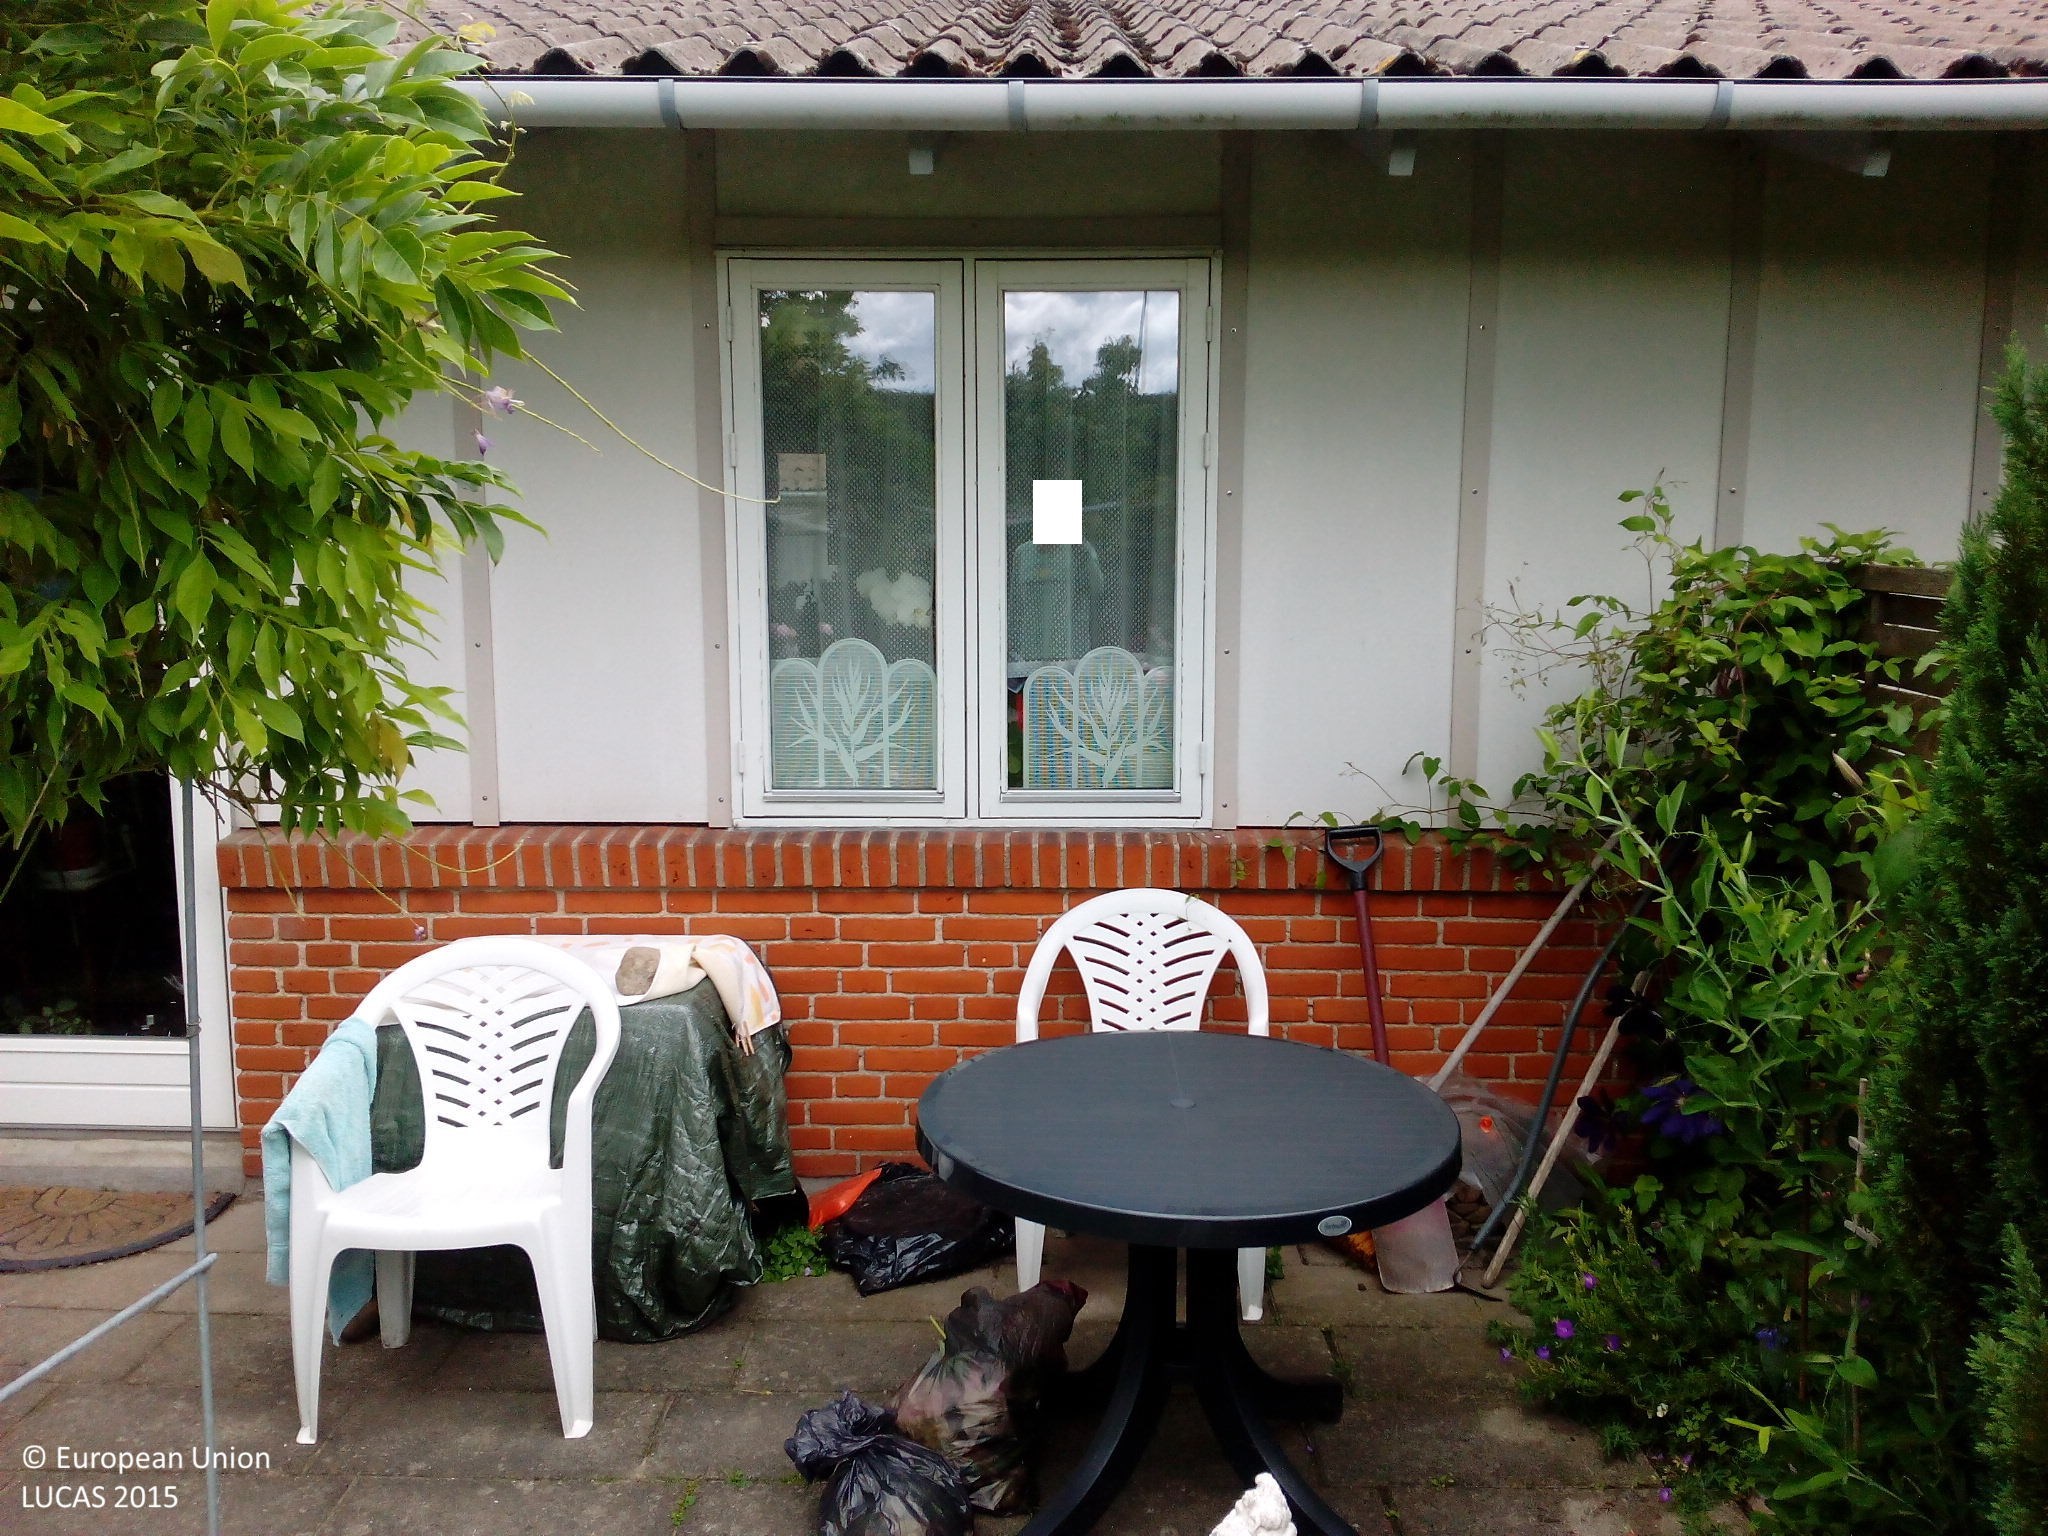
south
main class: Grassland
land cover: Grassland without tree/shrub cover
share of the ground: > 75 %
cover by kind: herbaceous plants 100 %
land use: Residential
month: July
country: DK
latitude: 55.2547
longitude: 12.0281
